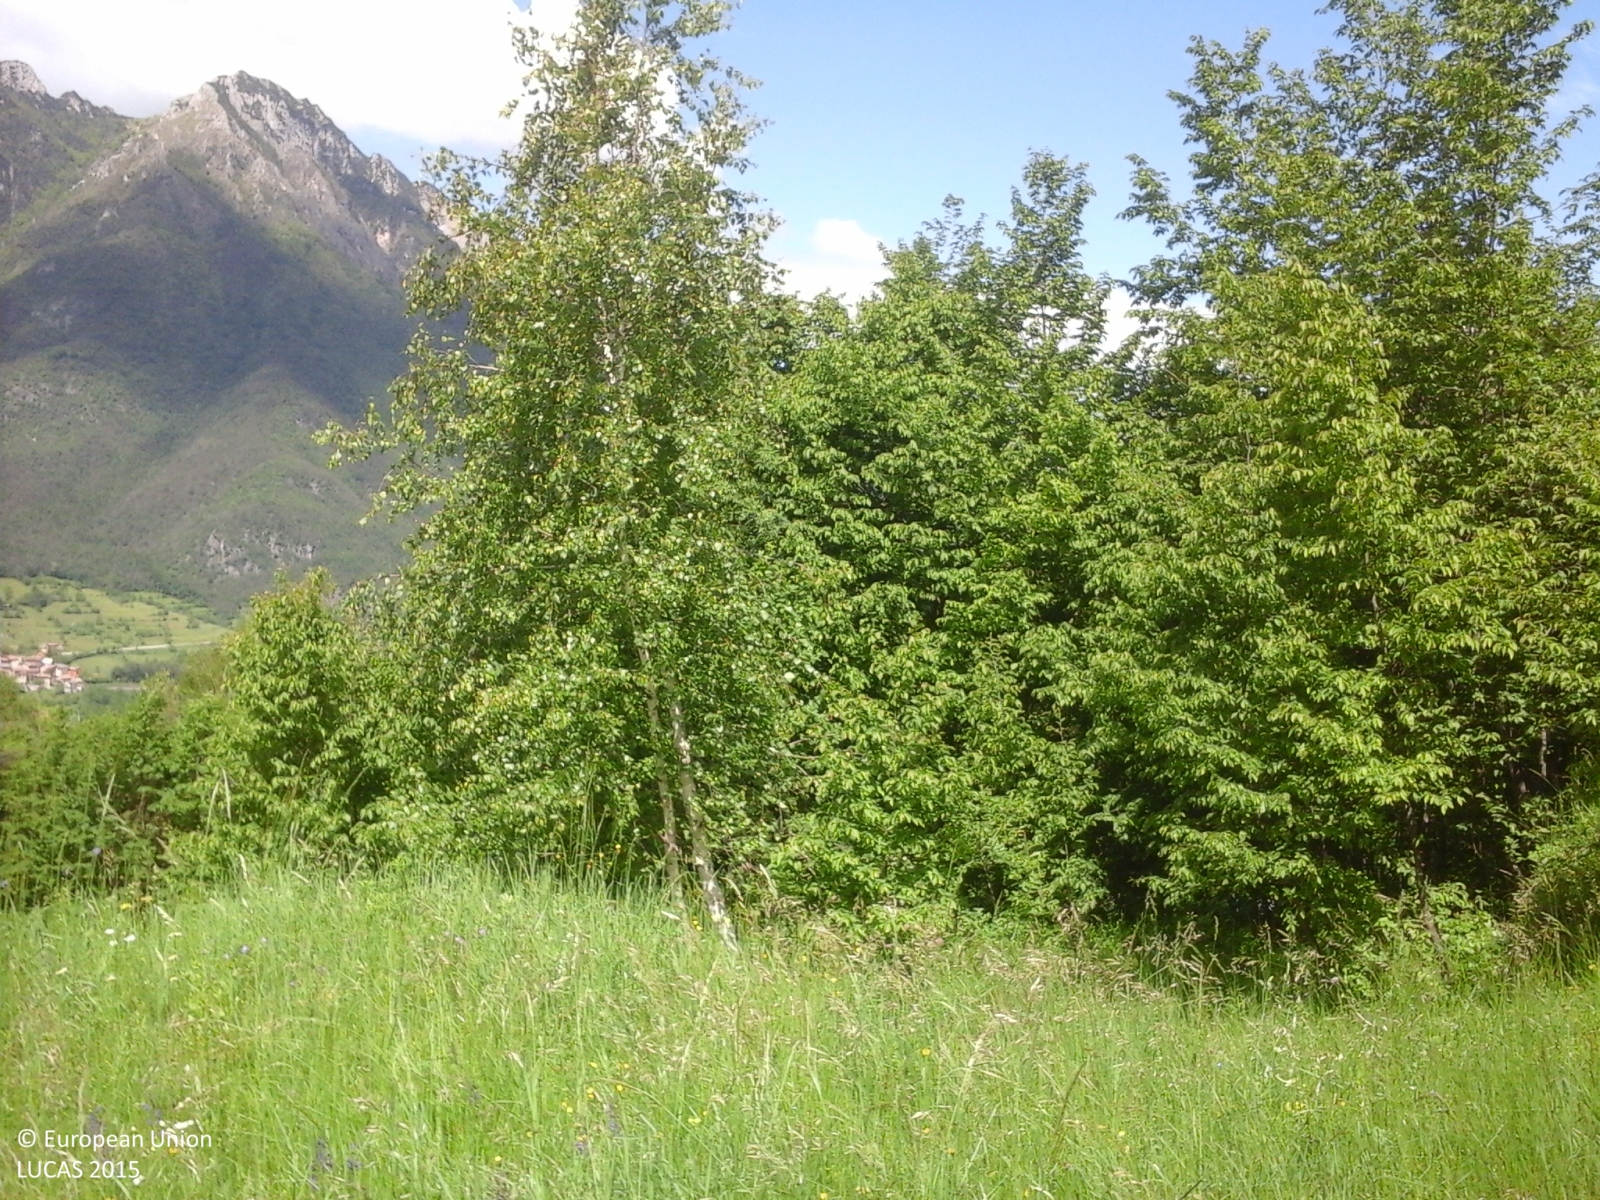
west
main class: Grassland
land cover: Grassland without tree/shrub cover
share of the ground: > 75 %
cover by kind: herbaceous plants 100 %
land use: Agriculture (excluding fallow land and kitchen gardens)
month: May
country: IT
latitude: 45.7868
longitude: 11.1174
